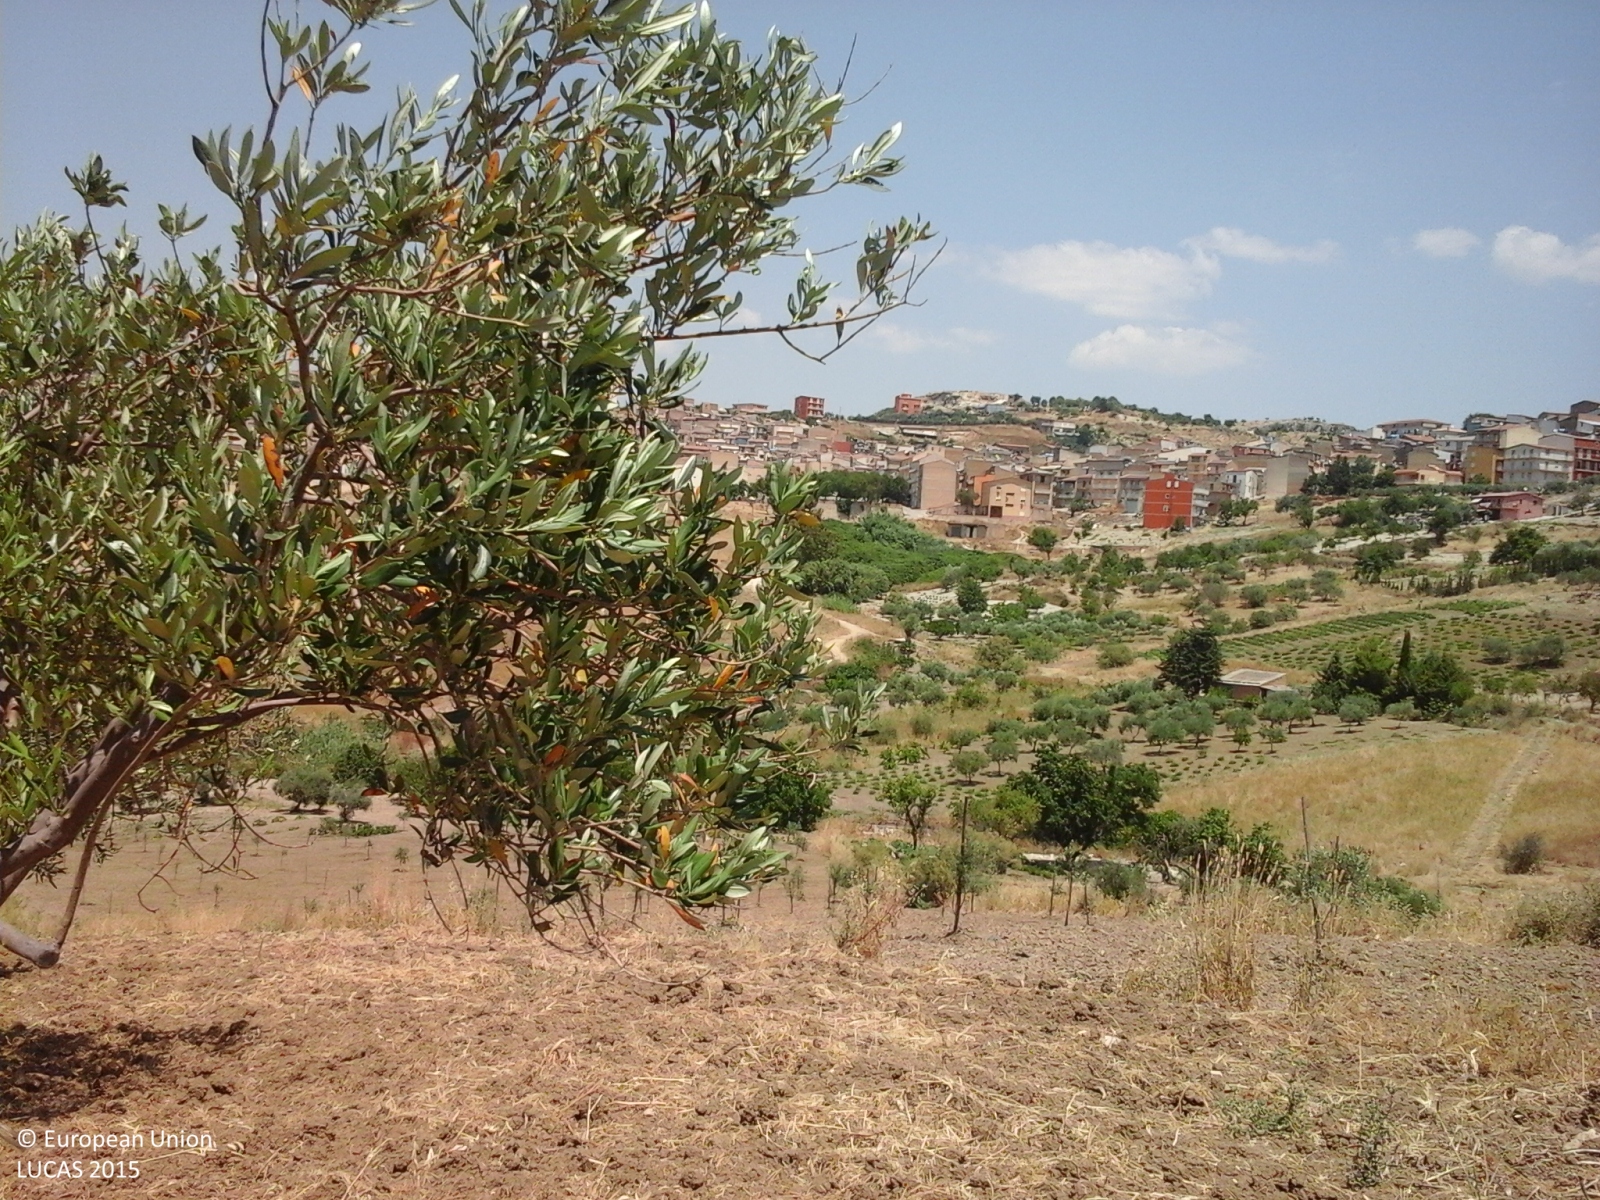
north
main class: Cropland
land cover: Olive groves
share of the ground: 25 - 50 %
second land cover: Other bare soil
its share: > 75 %
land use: Agriculture (excluding fallow land and kitchen gardens)
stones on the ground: < 10 %
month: July
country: IT
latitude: 37.4267
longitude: 13.5549
